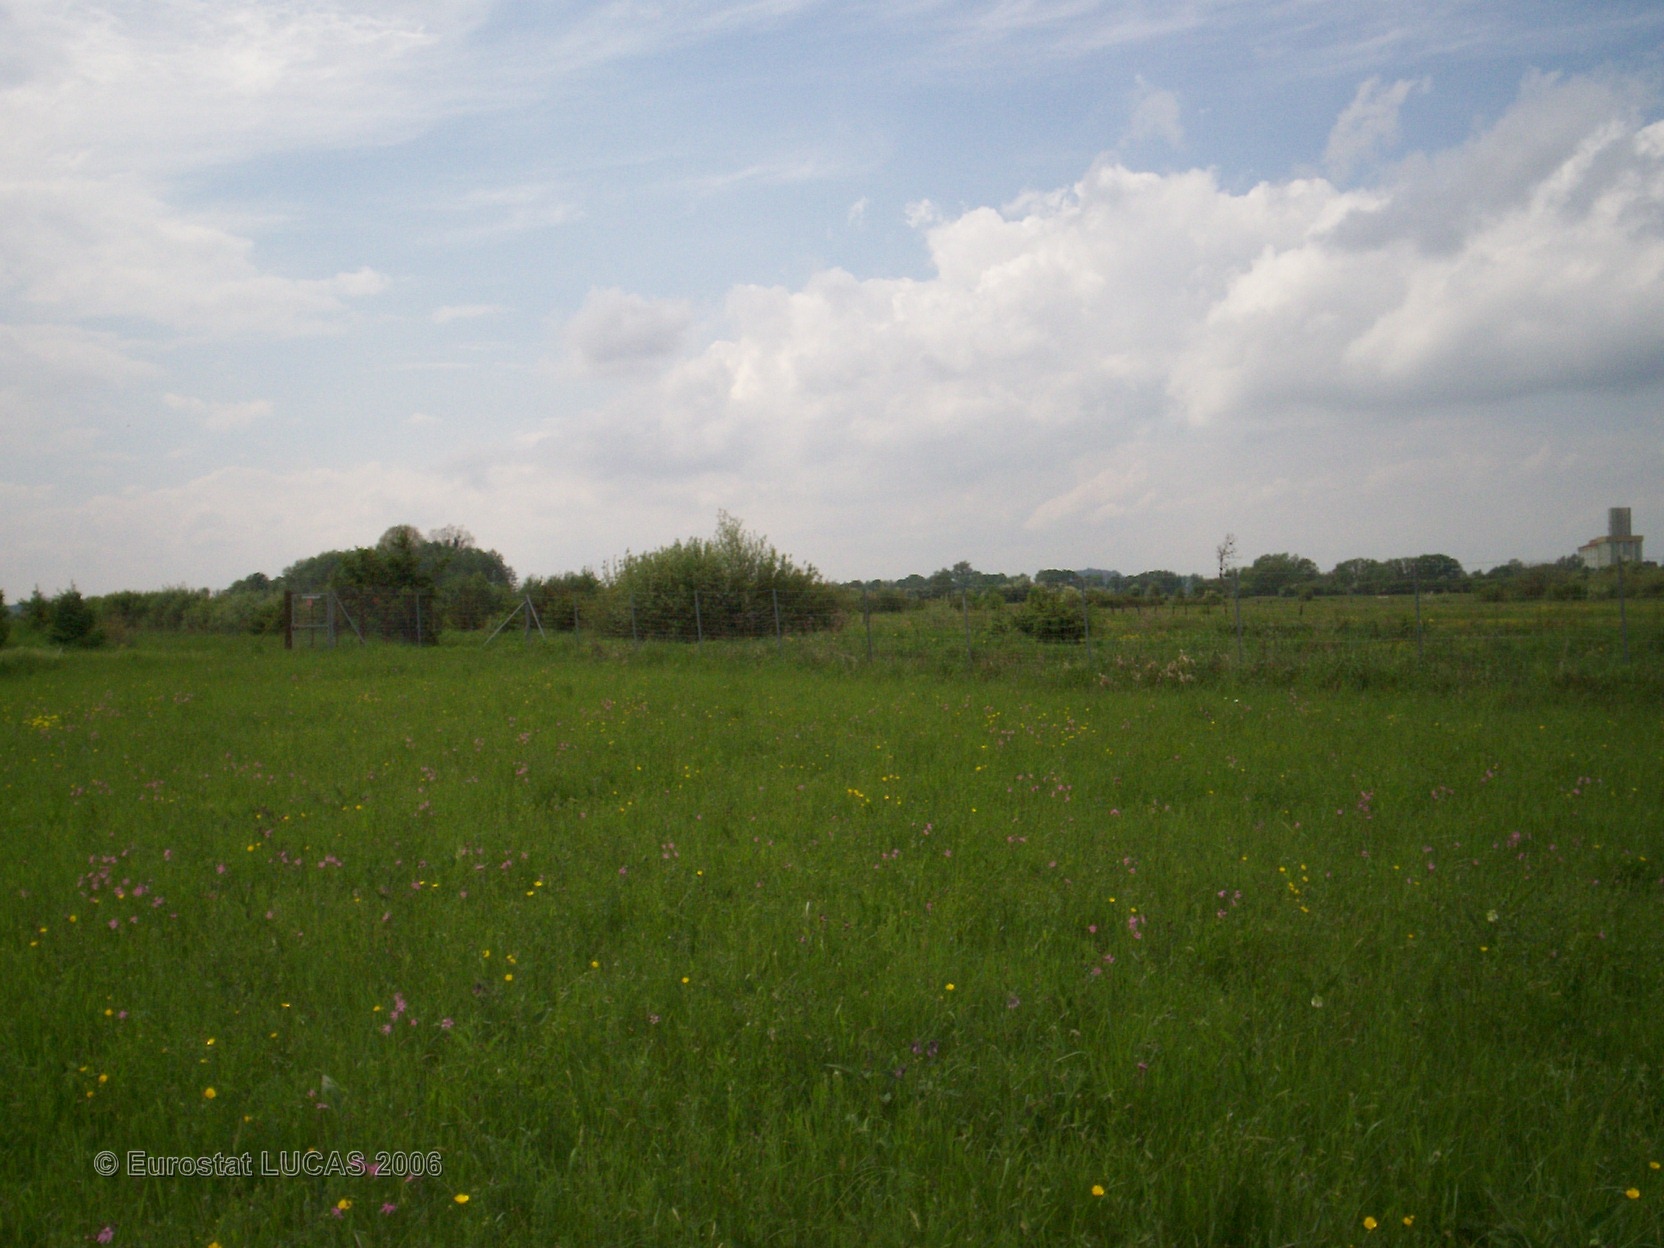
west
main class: Grassland
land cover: Grassland without tree/shrub cover
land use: Agriculture (excluding fallow land and kitchen gardens)
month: May
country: FR
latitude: 49.5791
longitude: 4.4224
